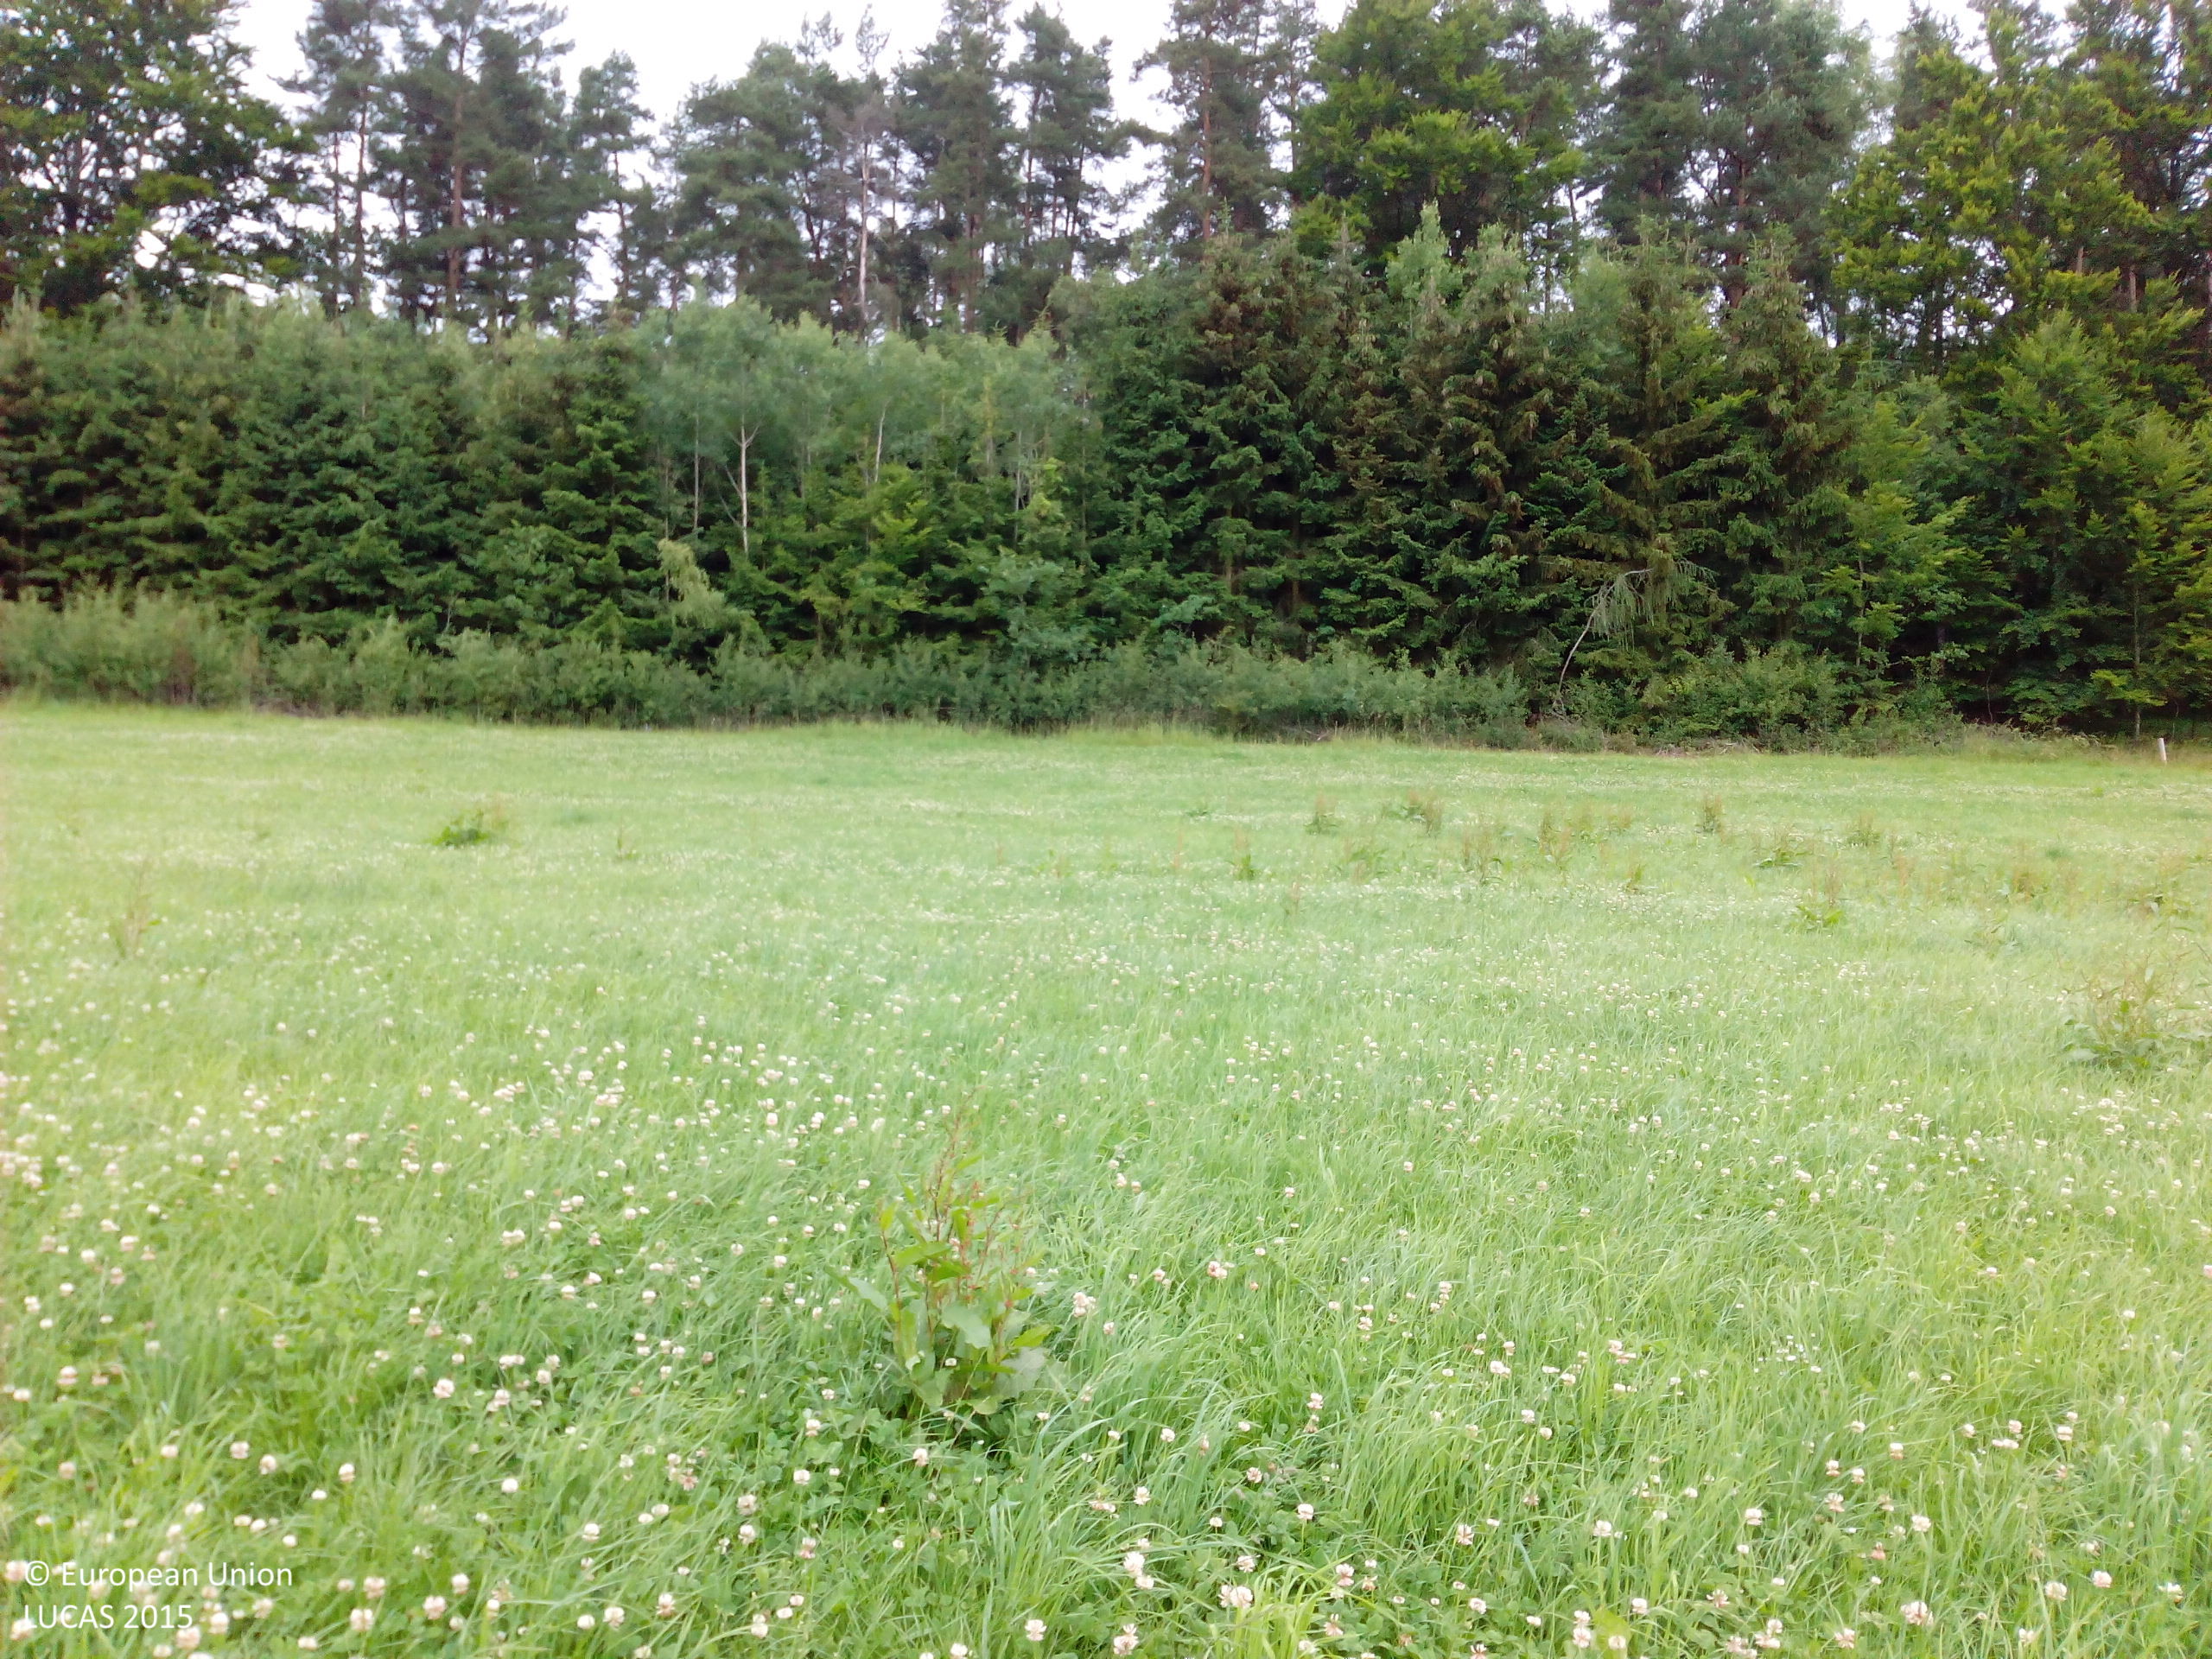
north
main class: Grassland
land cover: Grassland without tree/shrub cover
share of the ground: > 75 %
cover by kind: herbaceous plants 100 %
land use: Agriculture (excluding fallow land and kitchen gardens)
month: June
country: DE
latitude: 49.1149
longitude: 12.4244
